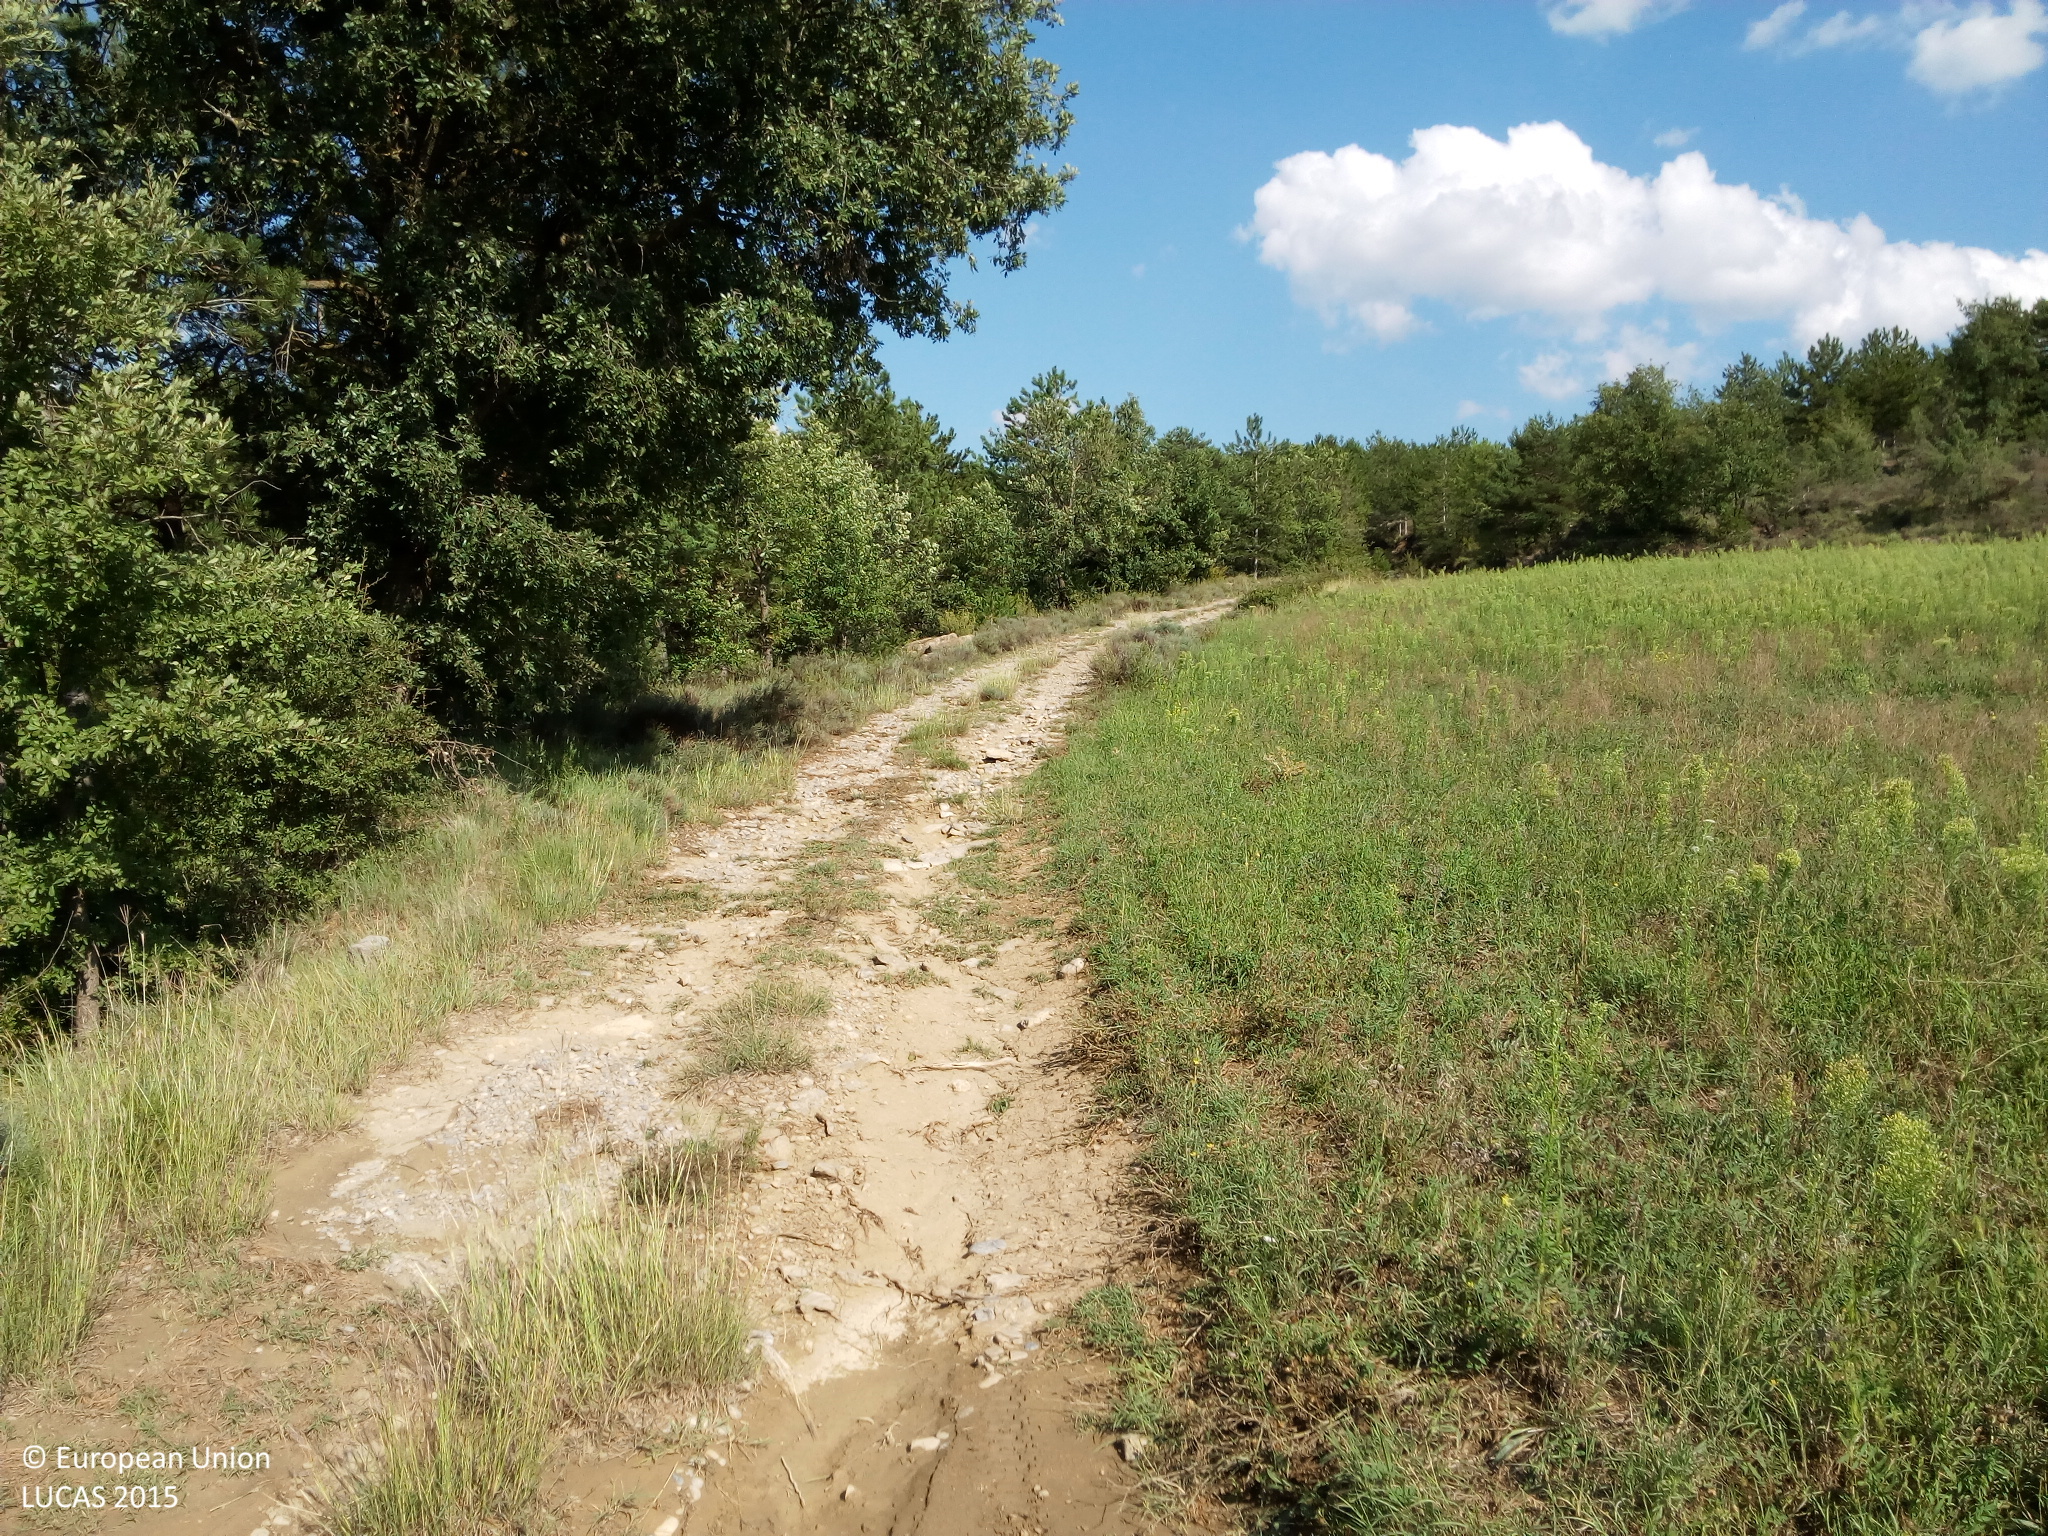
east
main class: Woodland
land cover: Pine dominated mixed woodland
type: coniferous forest of the mediterranean region
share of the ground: > 75 %
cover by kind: coniferous forest trees 50 %, shrubs 30 %, broadleaved forest trees 20 %
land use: Forestry
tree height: > 5 m
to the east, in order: Pine dominated mixed woodland; Shrubland without tree cover; Pine dominated mixed woodland
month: August
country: ES
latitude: 42.2266
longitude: 0.5200
